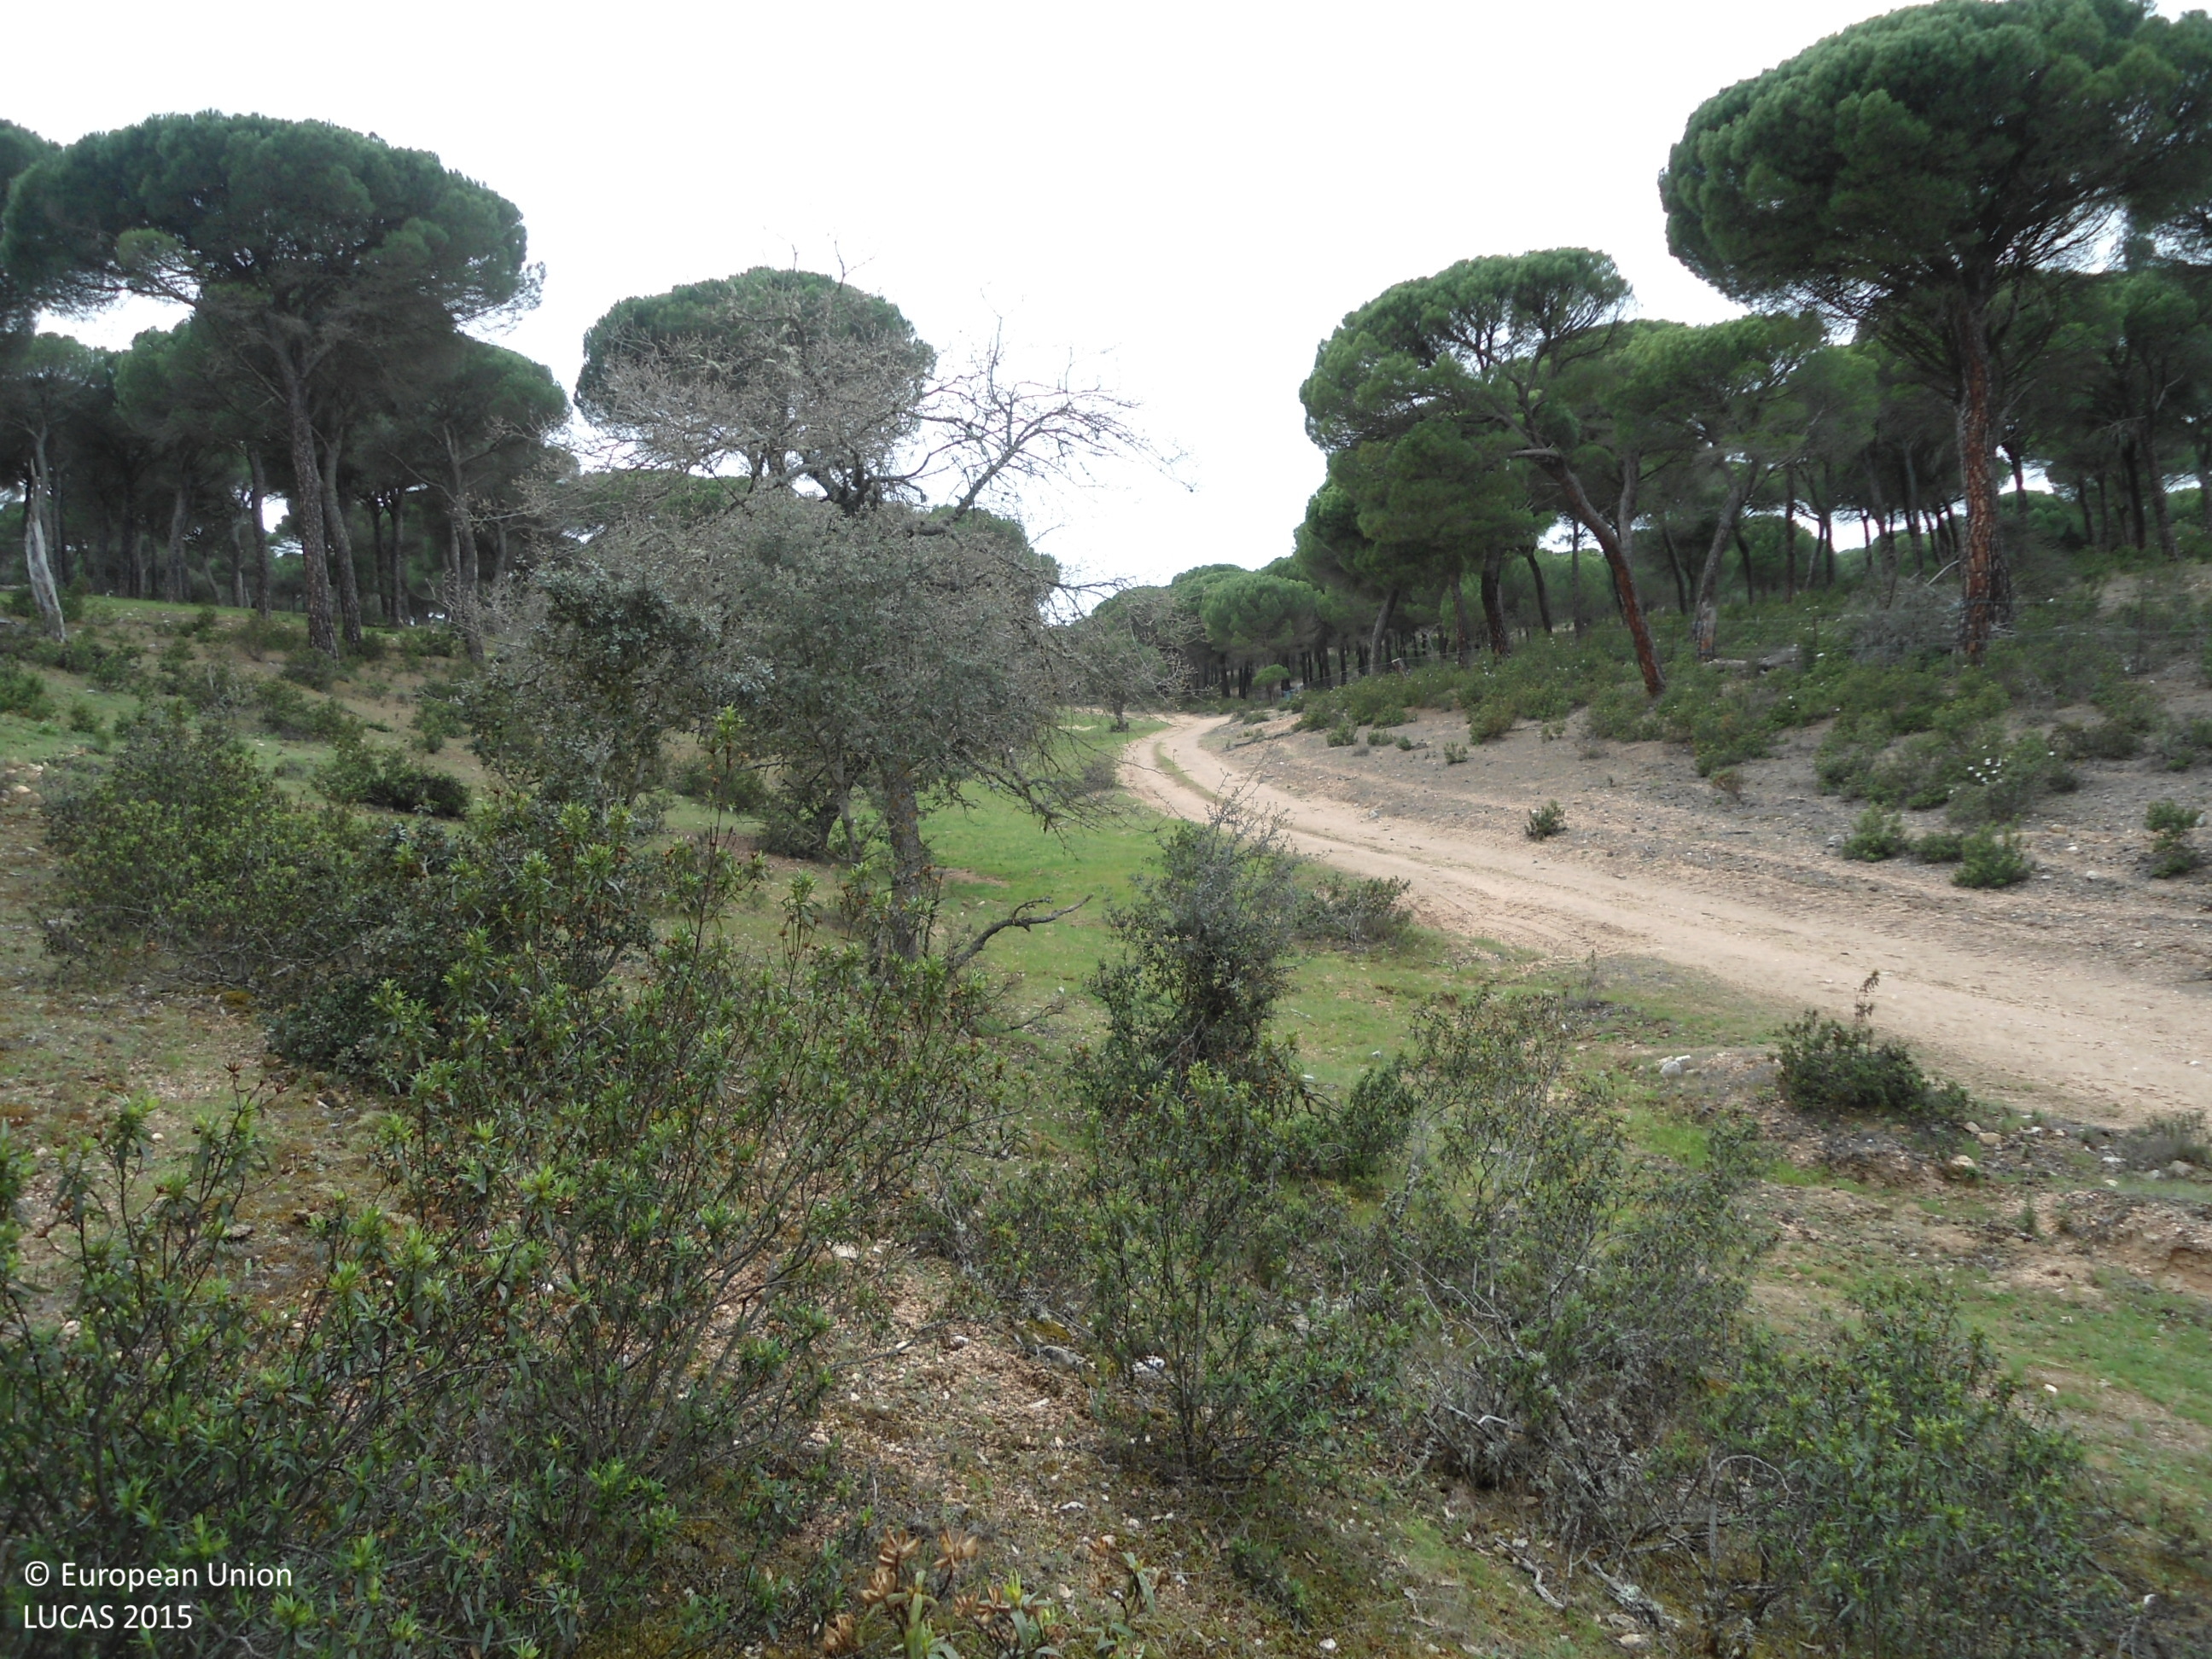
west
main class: Woodland
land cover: Pine dominated coniferous woodland
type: coniferous forest of the mediterranean region
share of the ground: > 75 %
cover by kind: coniferous forest trees 80 %, shrubs 10 %, herbaceous plants 10 %
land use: Agriculture (excluding fallow land and kitchen gardens)
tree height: > 5 m
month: April
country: ES
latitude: 41.5470
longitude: -5.8292
